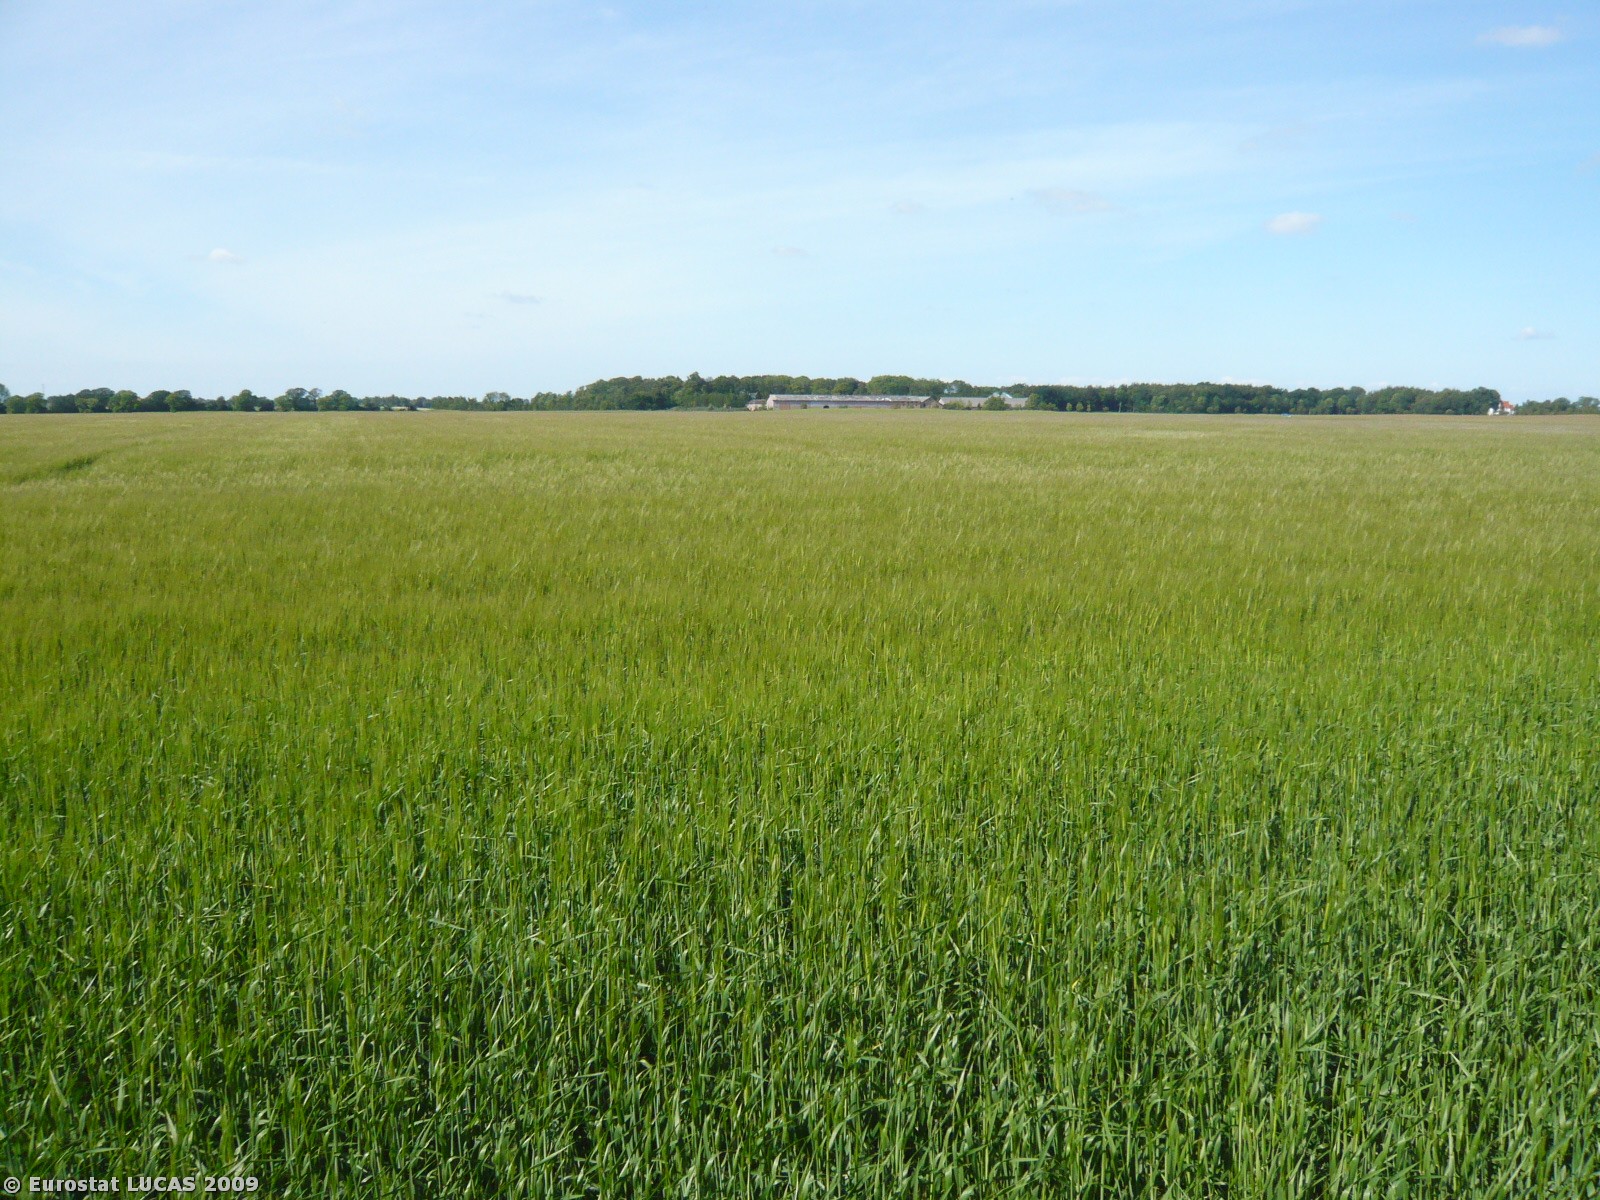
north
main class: Cropland
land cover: Barley
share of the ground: > 75 %
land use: Agriculture (excluding fallow land and kitchen gardens)
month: June
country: DK
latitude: 54.7791
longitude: 11.2896
